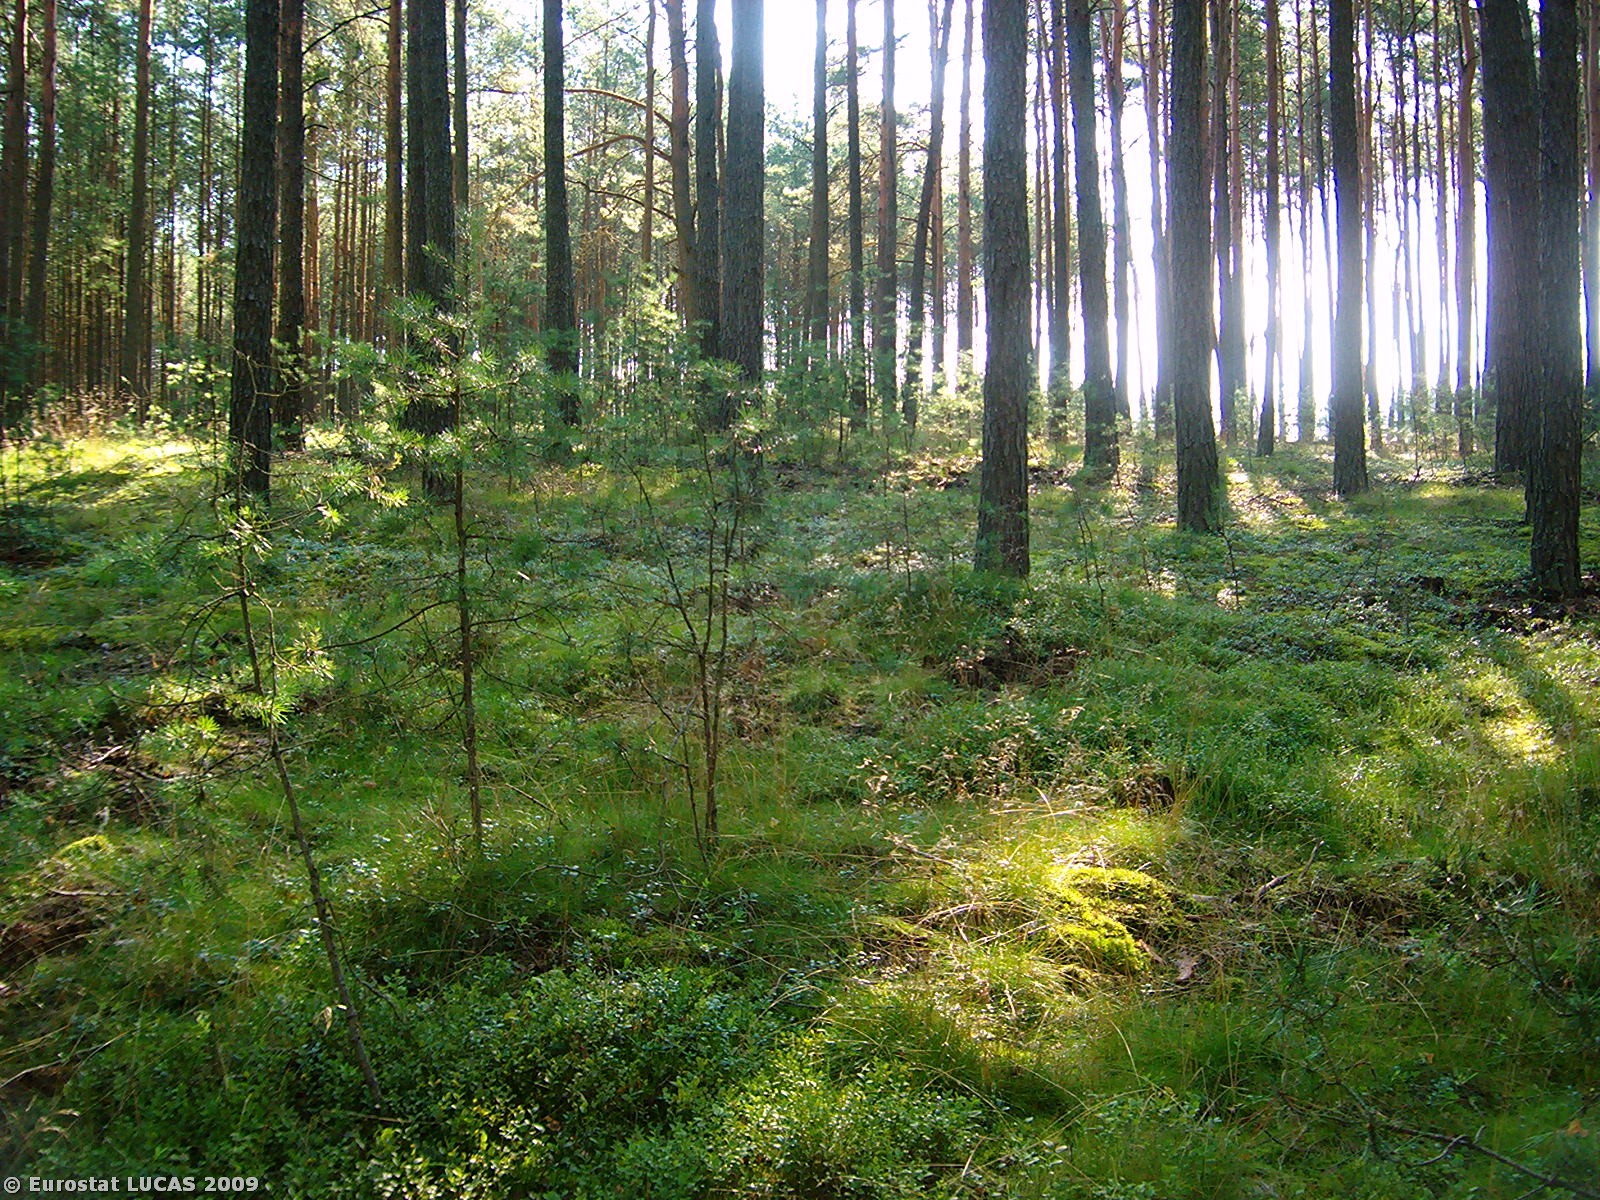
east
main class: Woodland
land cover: Coniferous woodland
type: hemiboreal forest and nemoral coniferous forest and mixed broadleaved-coniferous forest
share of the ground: 50 - 75 %
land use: Forestry
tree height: > 5 m
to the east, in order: Coniferous woodland; Tracks; Coniferous woodland; Grassland with sparse tree/shrub cover; Coniferous woodland
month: August
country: PL
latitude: 52.8794
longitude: 15.9041
